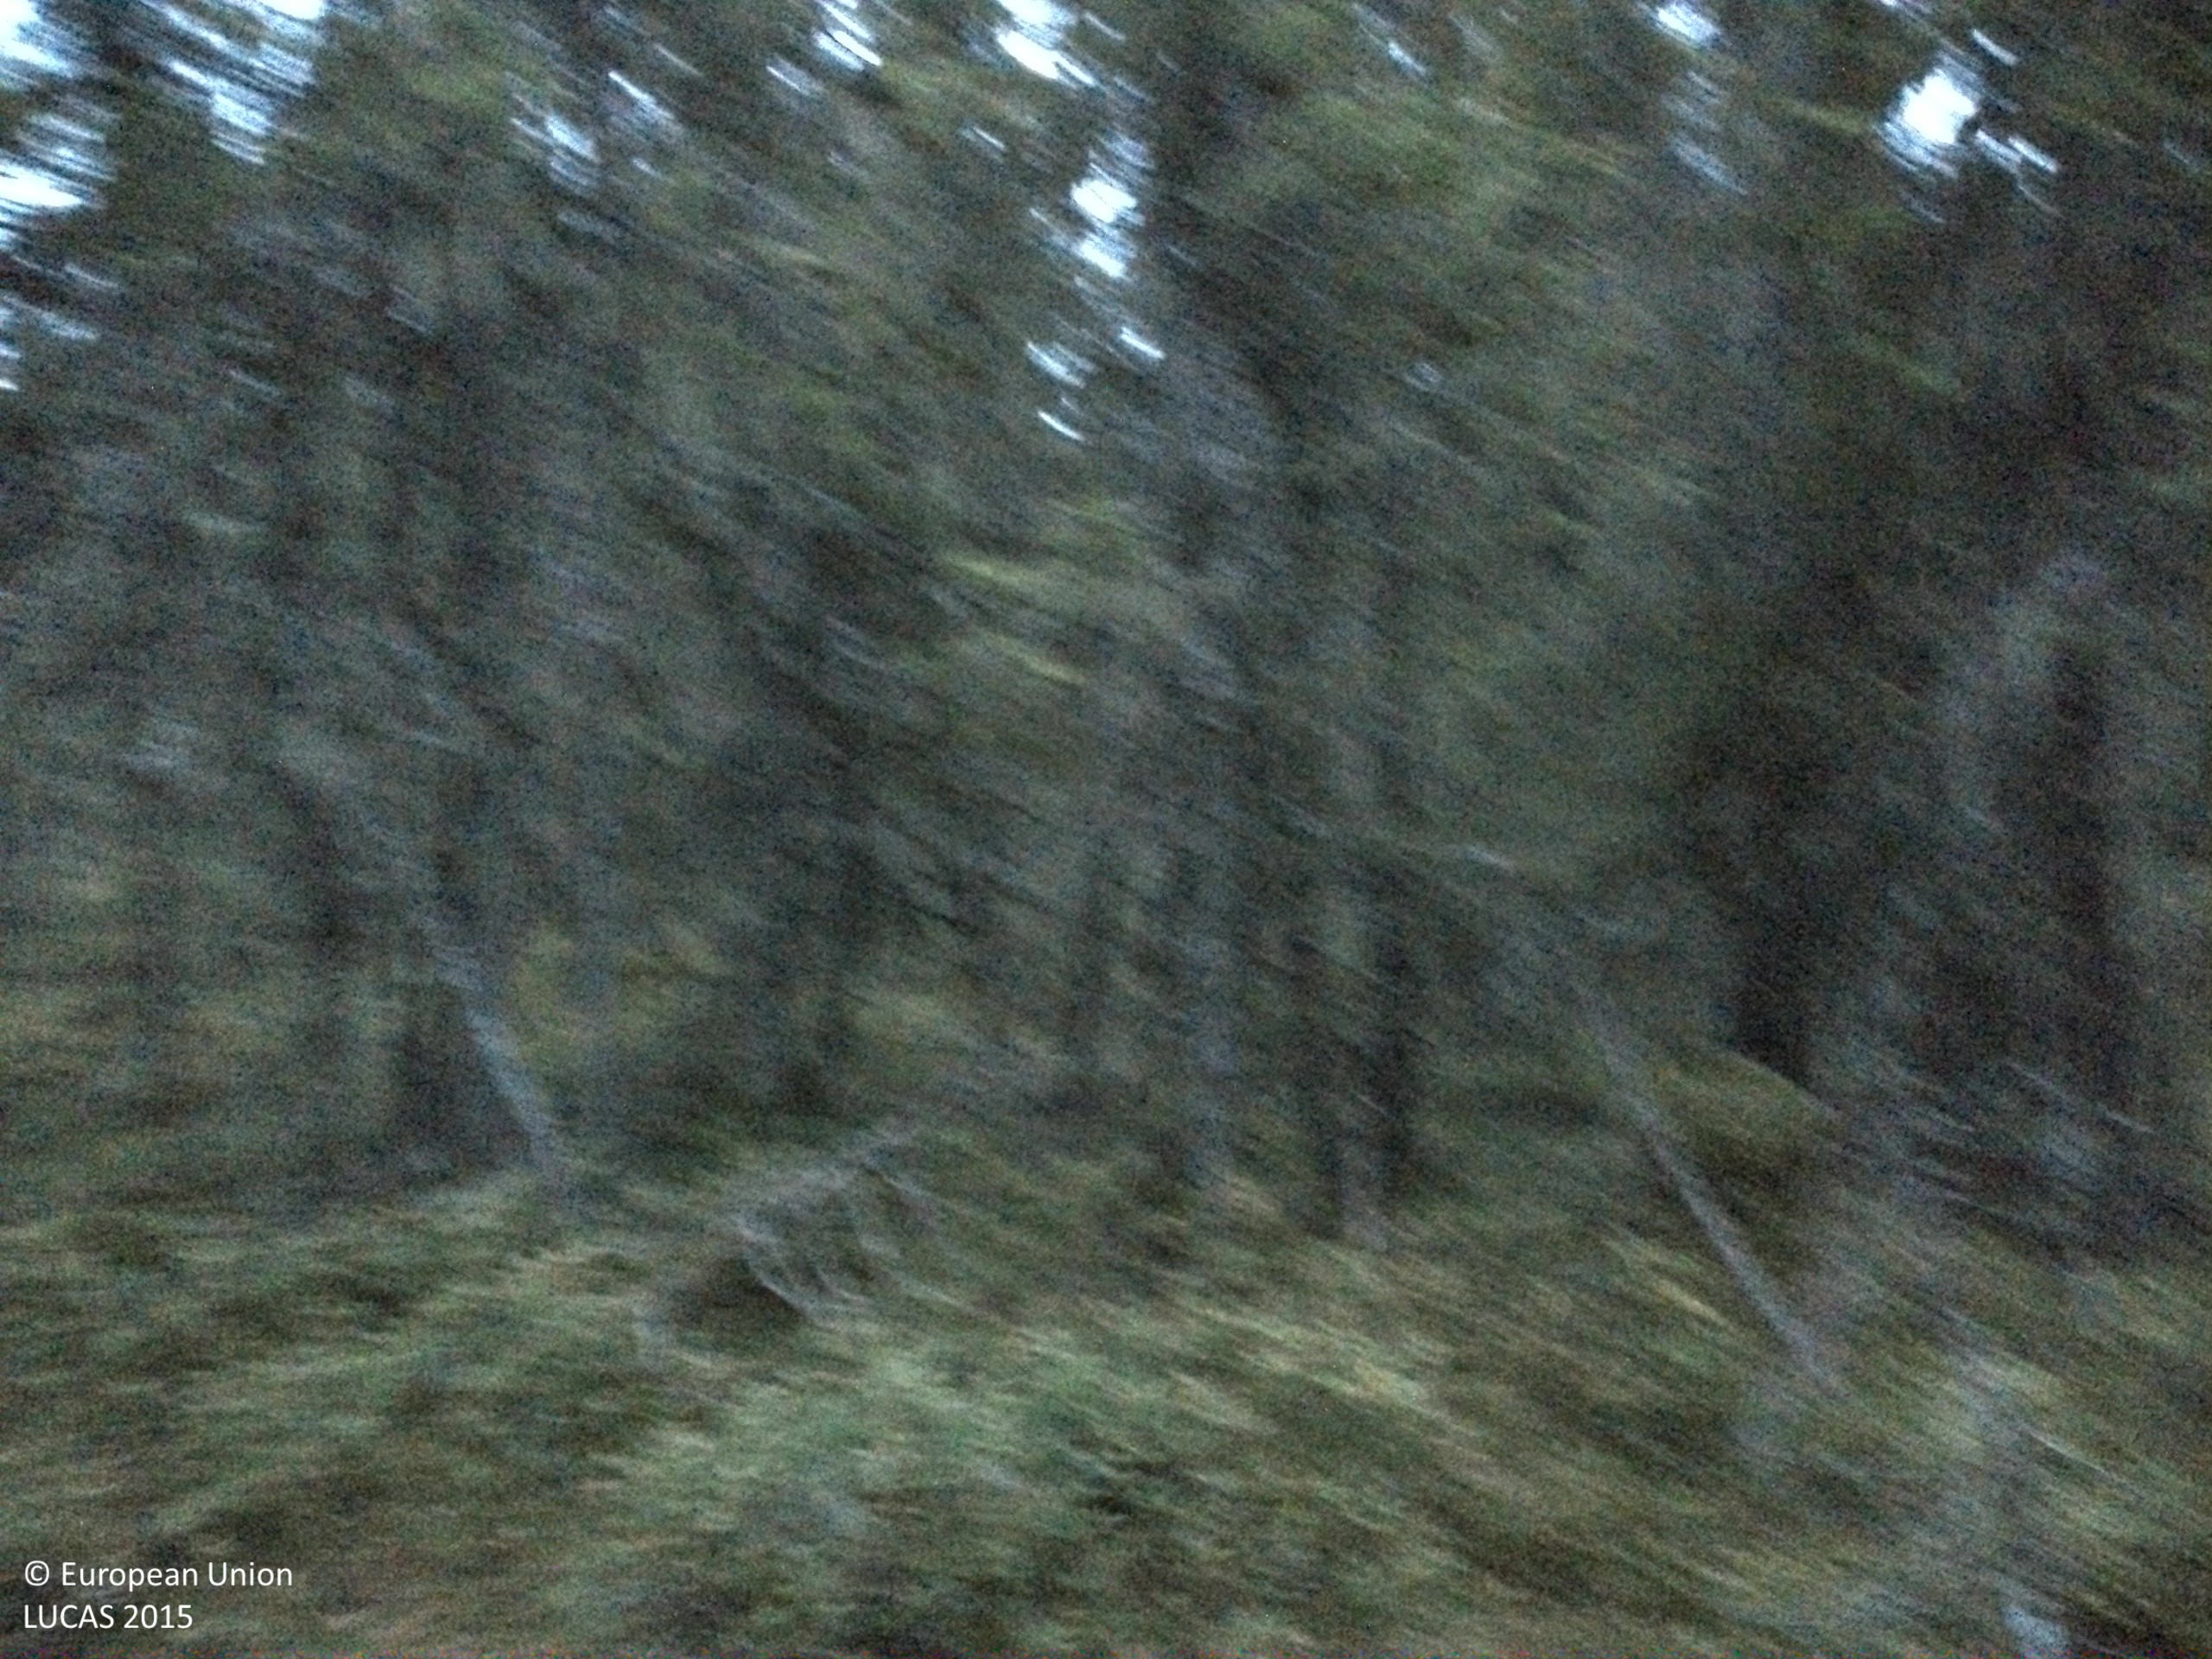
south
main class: Woodland
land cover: Spruce dominated coniferous woodland
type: boreal forest
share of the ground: 50 - 75 %
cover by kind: coniferous forest trees 65 %, shrubs 30 %, broadleaved forest trees 5 %
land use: Forestry
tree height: > 5 m
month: October
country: SE
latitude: 61.3943
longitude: 14.3482
